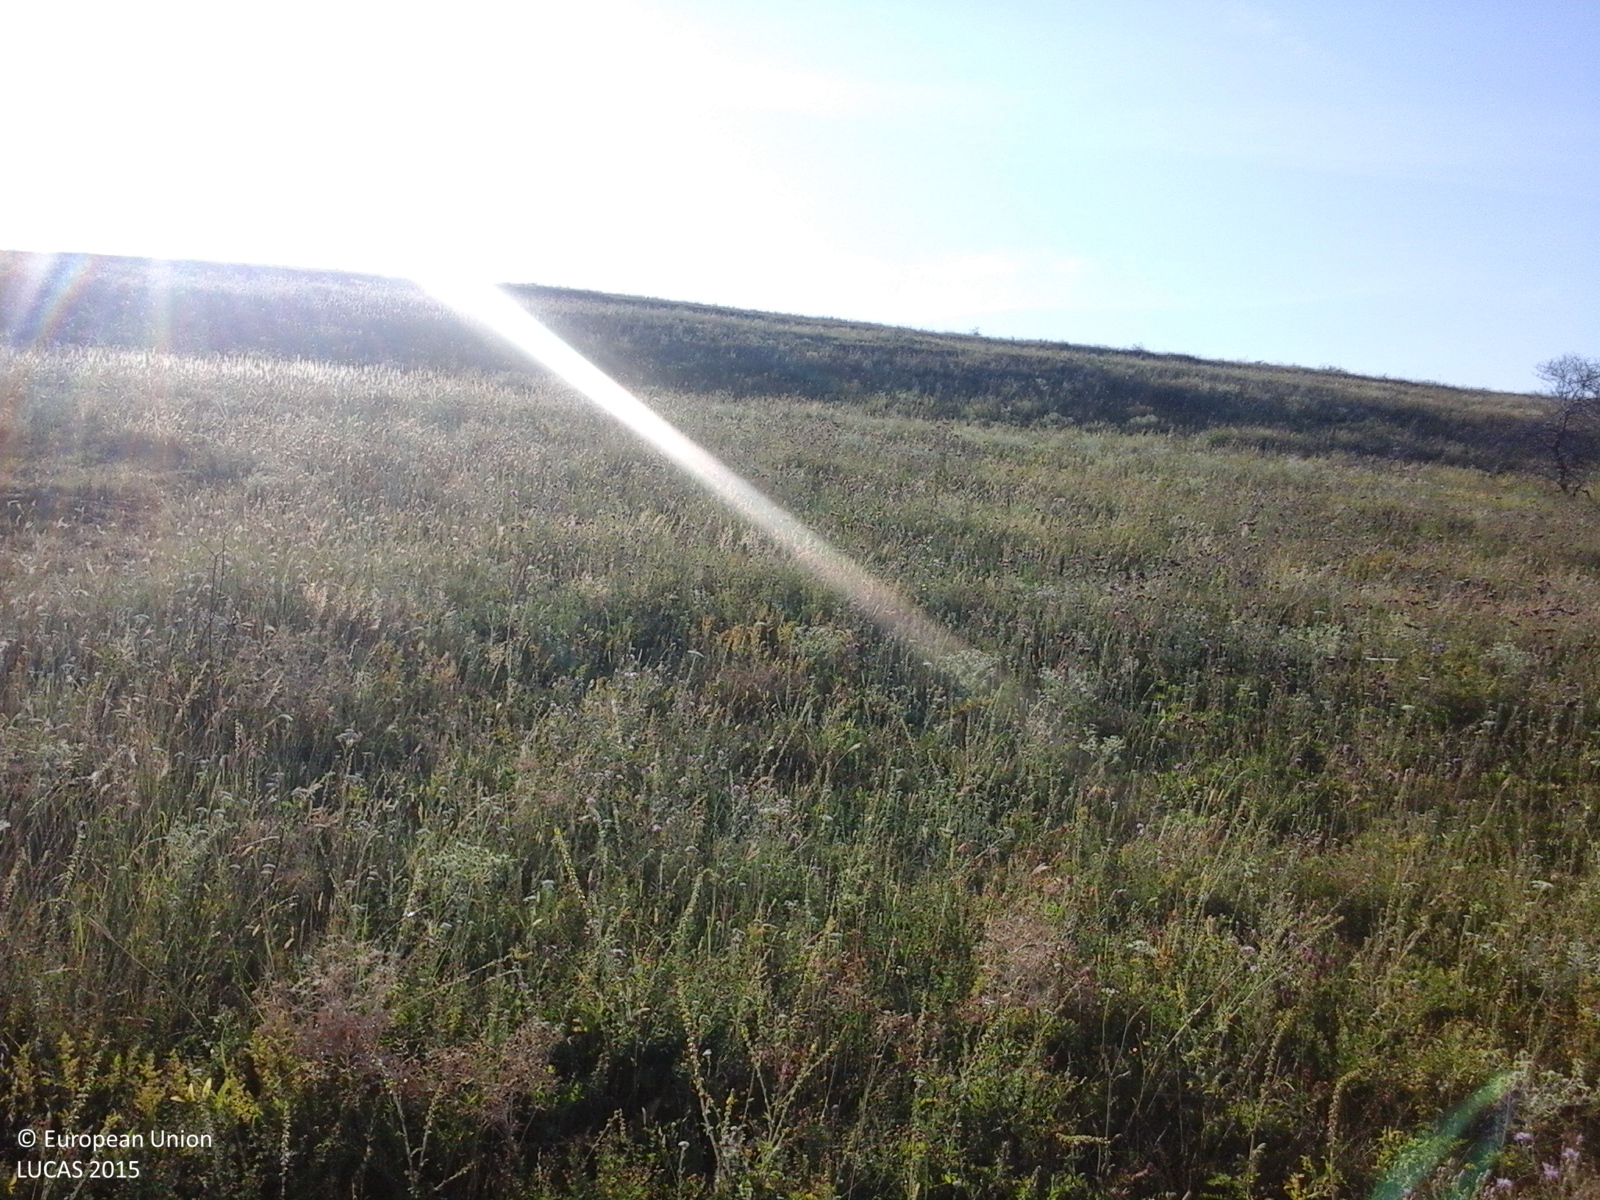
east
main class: Grassland
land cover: Grassland without tree/shrub cover
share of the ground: > 75 %
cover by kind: herbaceous plants 100 %
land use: Agriculture (excluding fallow land and kitchen gardens)
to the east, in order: Grassland without tree/shrub cover; Tracks; Grassland with sparse tree/shrub cover
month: July
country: RO
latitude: 46.5844
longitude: 27.1850
